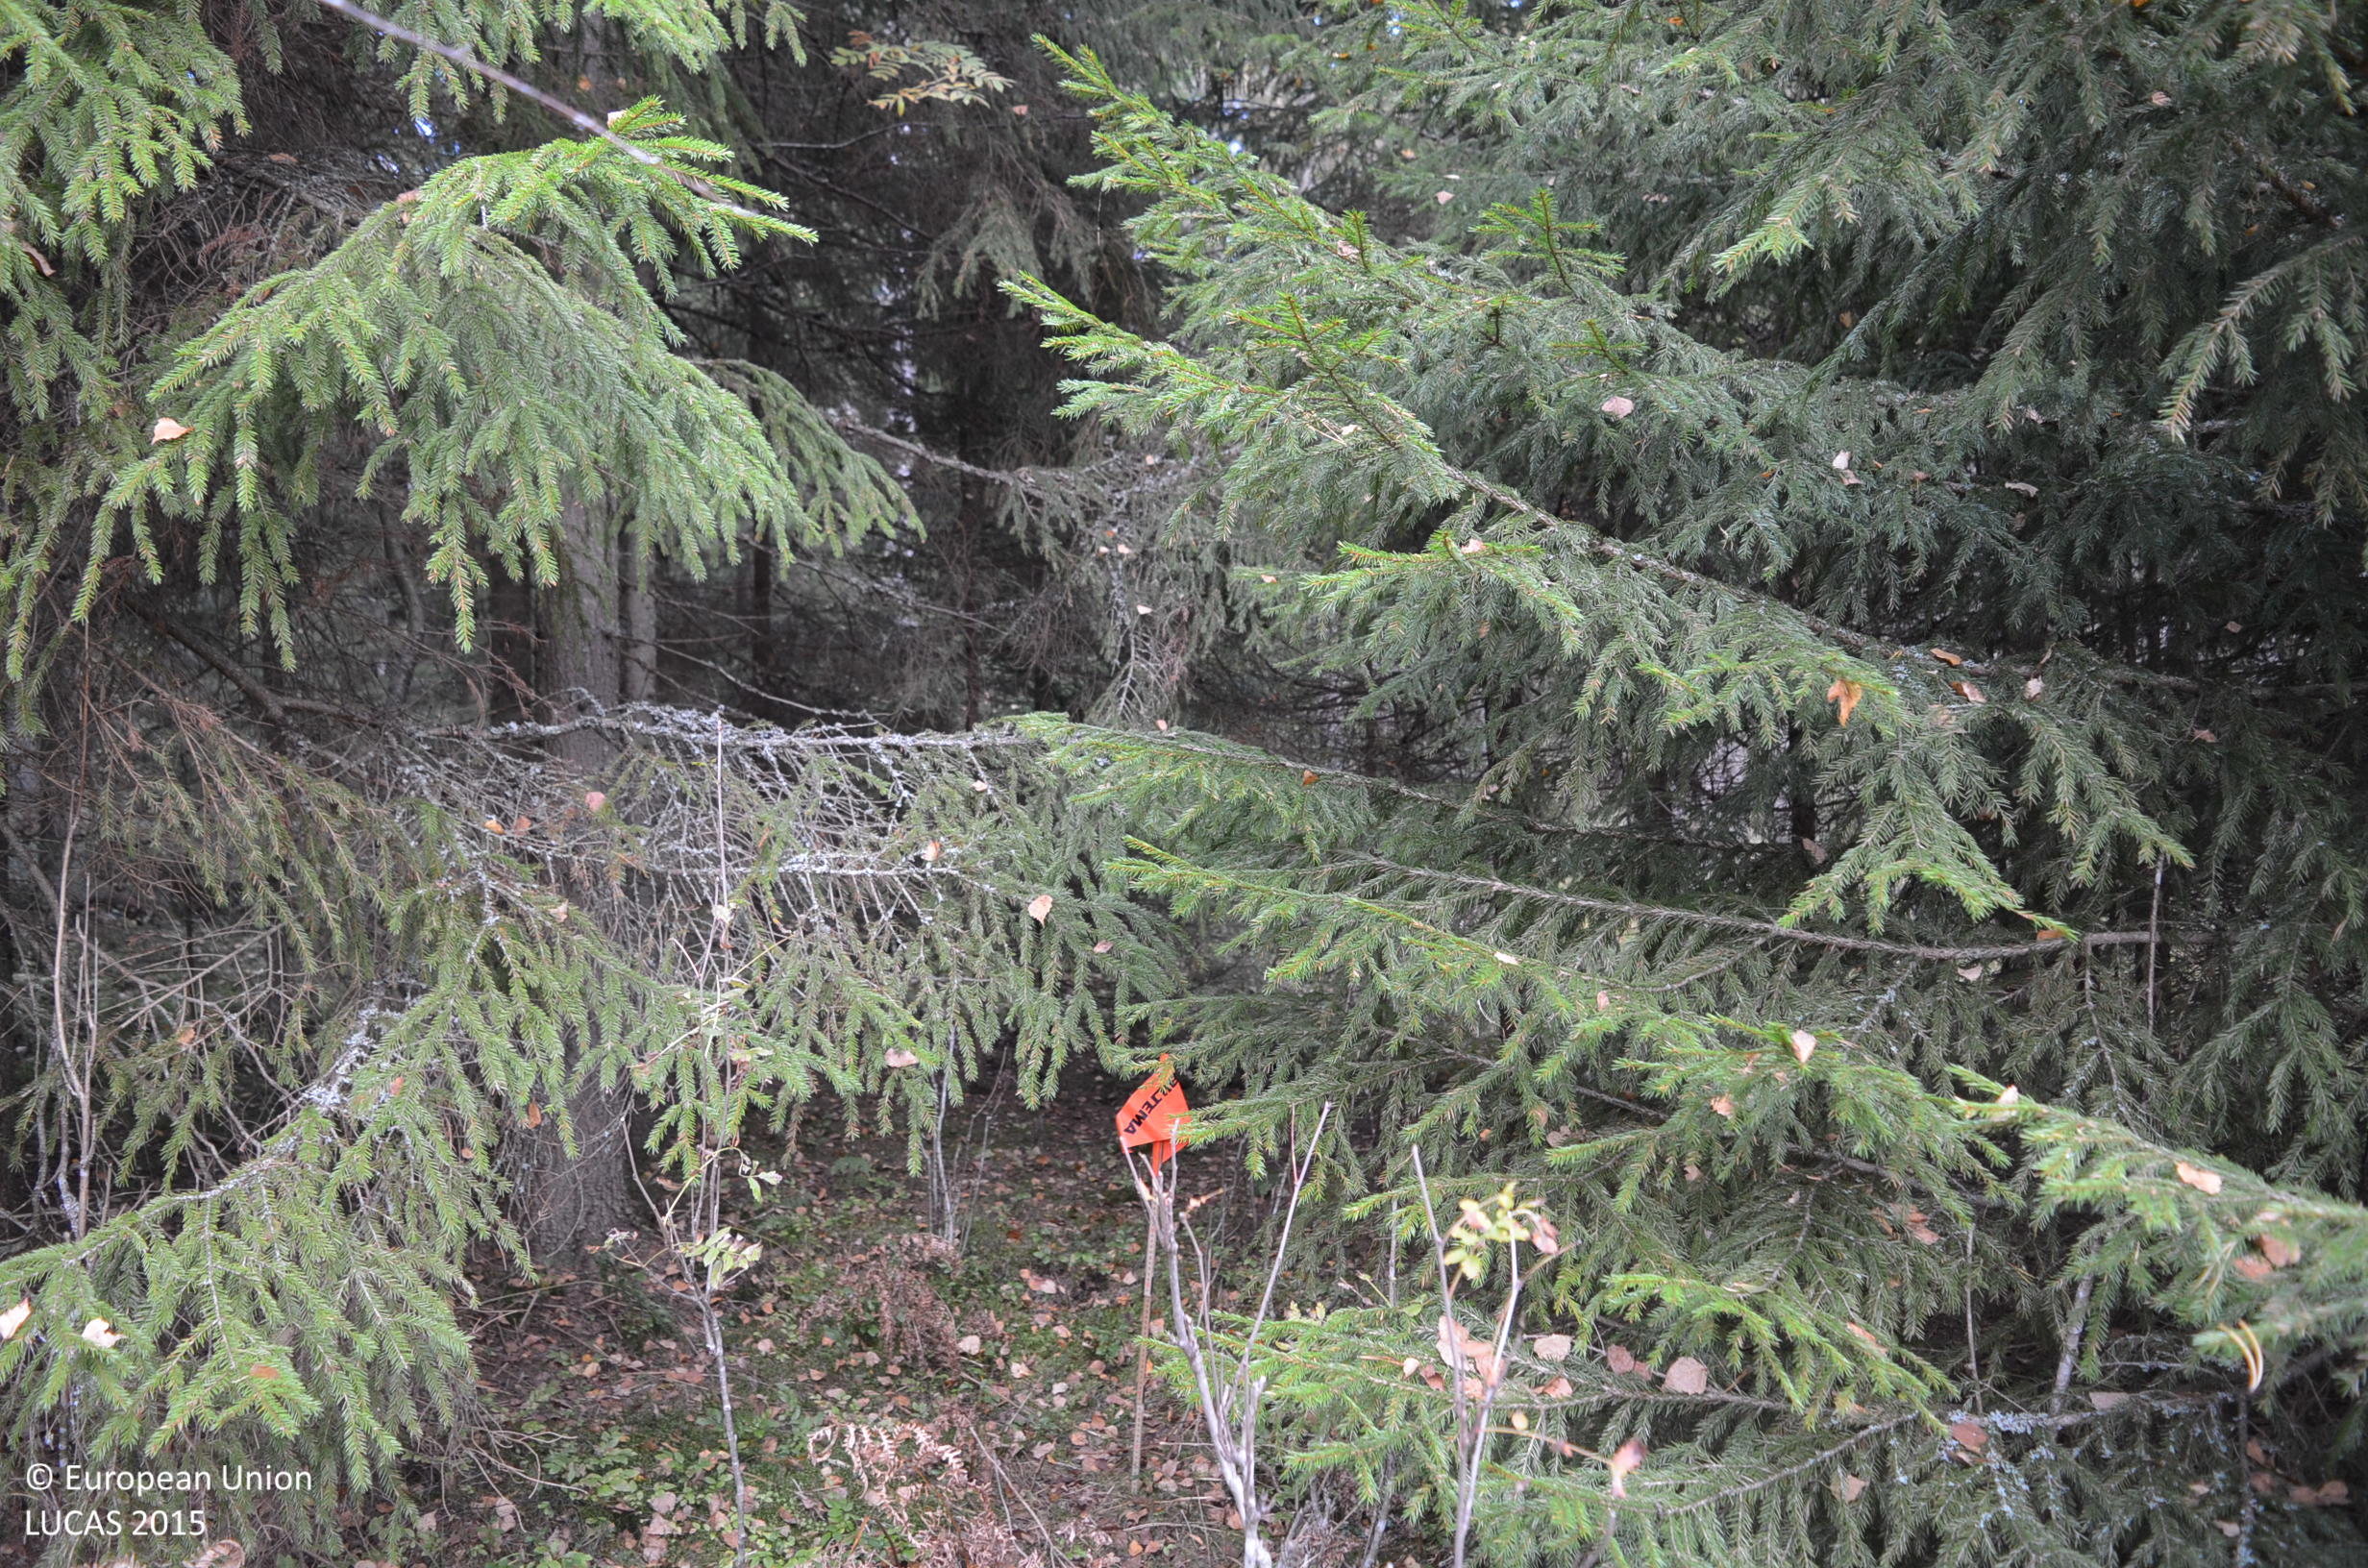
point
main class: Woodland
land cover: Spruce dominated mixed woodland
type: boreal forest
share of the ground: > 75 %
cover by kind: coniferous forest trees 55 %, broadleaved forest trees 20 %, shrubs 10 %, lichens and mosses 10 %, herbaceous plants 5 %
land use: Forestry
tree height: > 5 m
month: October
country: FI
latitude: 61.4643
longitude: 23.1531
